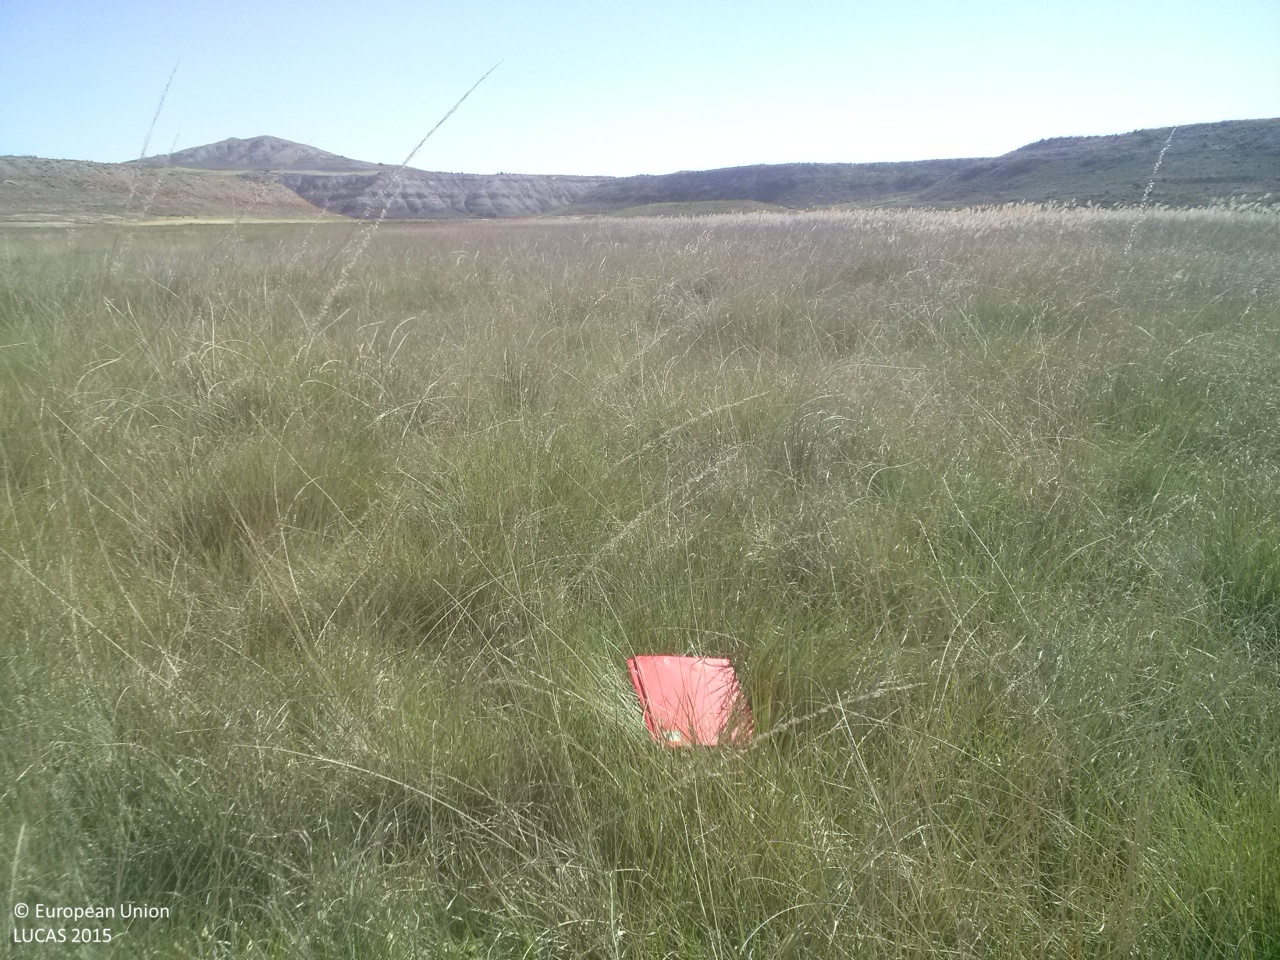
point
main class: Grassland
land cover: Grassland without tree/shrub cover
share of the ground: > 75 %
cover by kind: herbaceous plants 100 %
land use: Semi-natural and natural areas not in use
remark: Temporary flooded
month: May
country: ES
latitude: 40.1827
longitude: -2.7425
